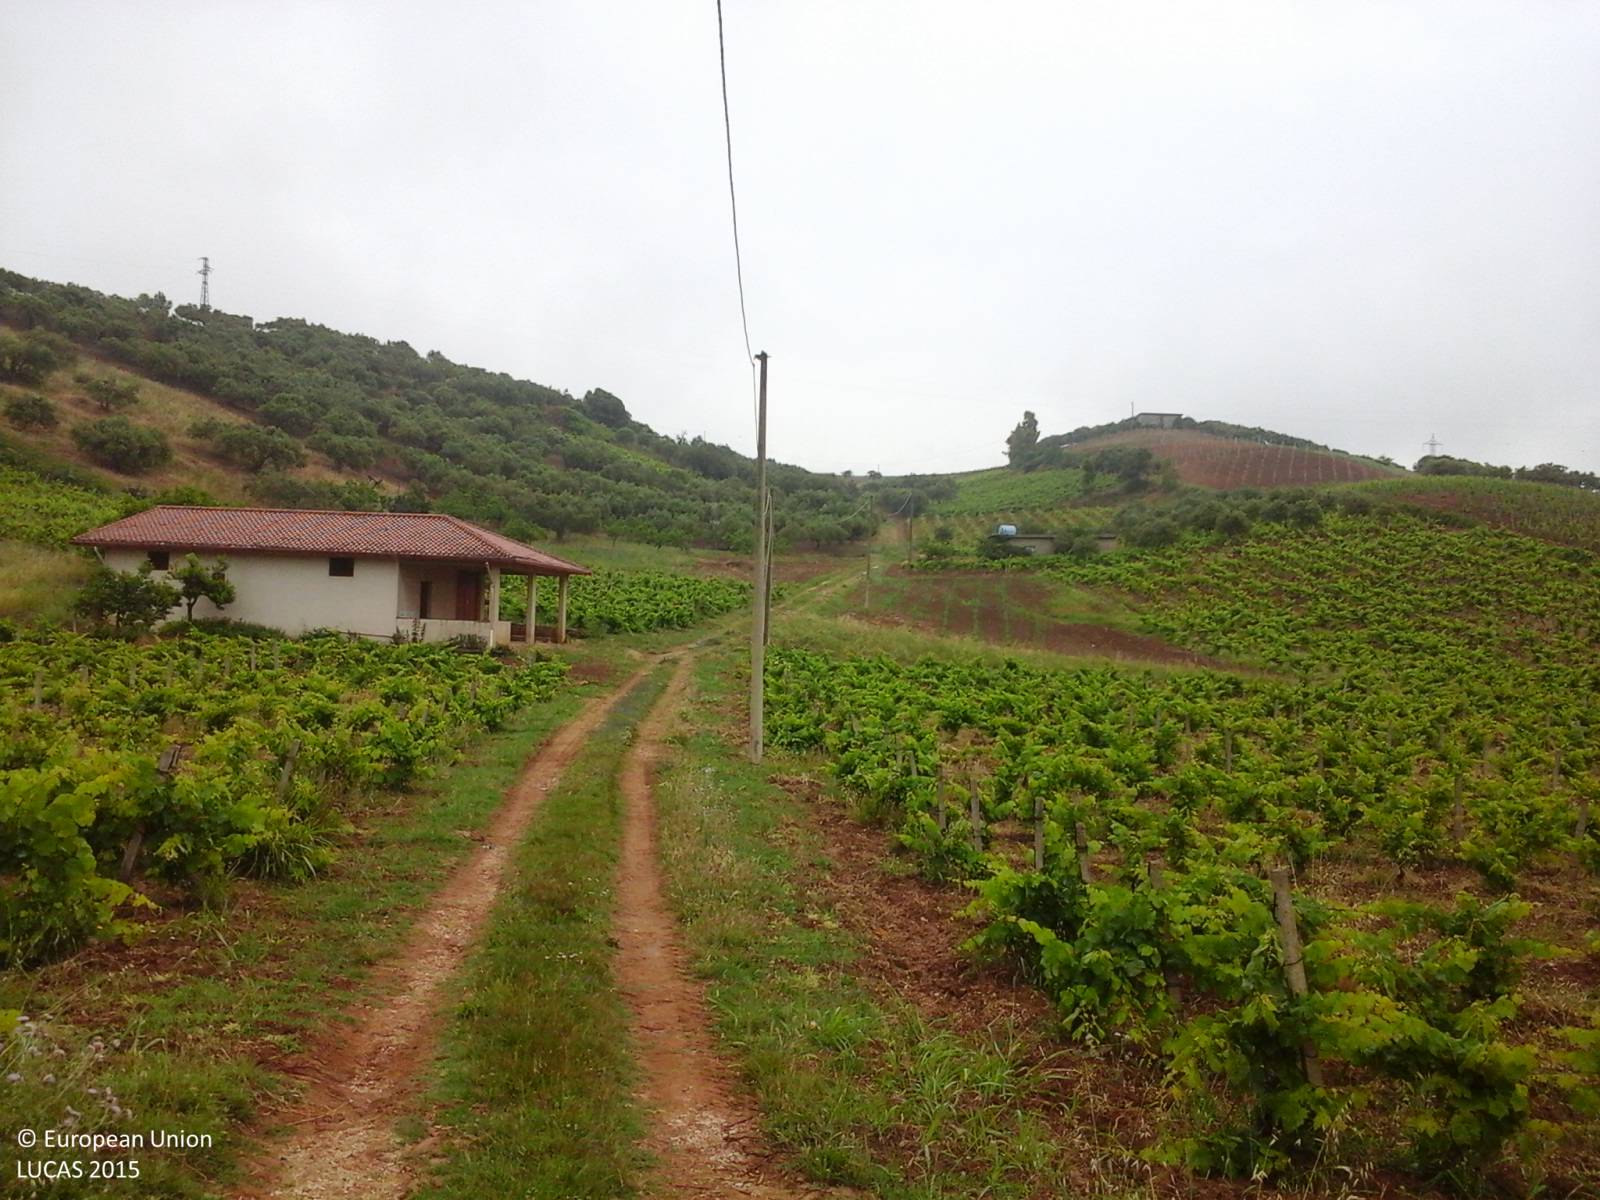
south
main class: Cropland
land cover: Vineyards
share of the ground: > 75 %
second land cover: Other bare soil
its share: > 75 %
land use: Agriculture (excluding fallow land and kitchen gardens)
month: May
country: IT
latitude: 37.9496
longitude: 13.1524
